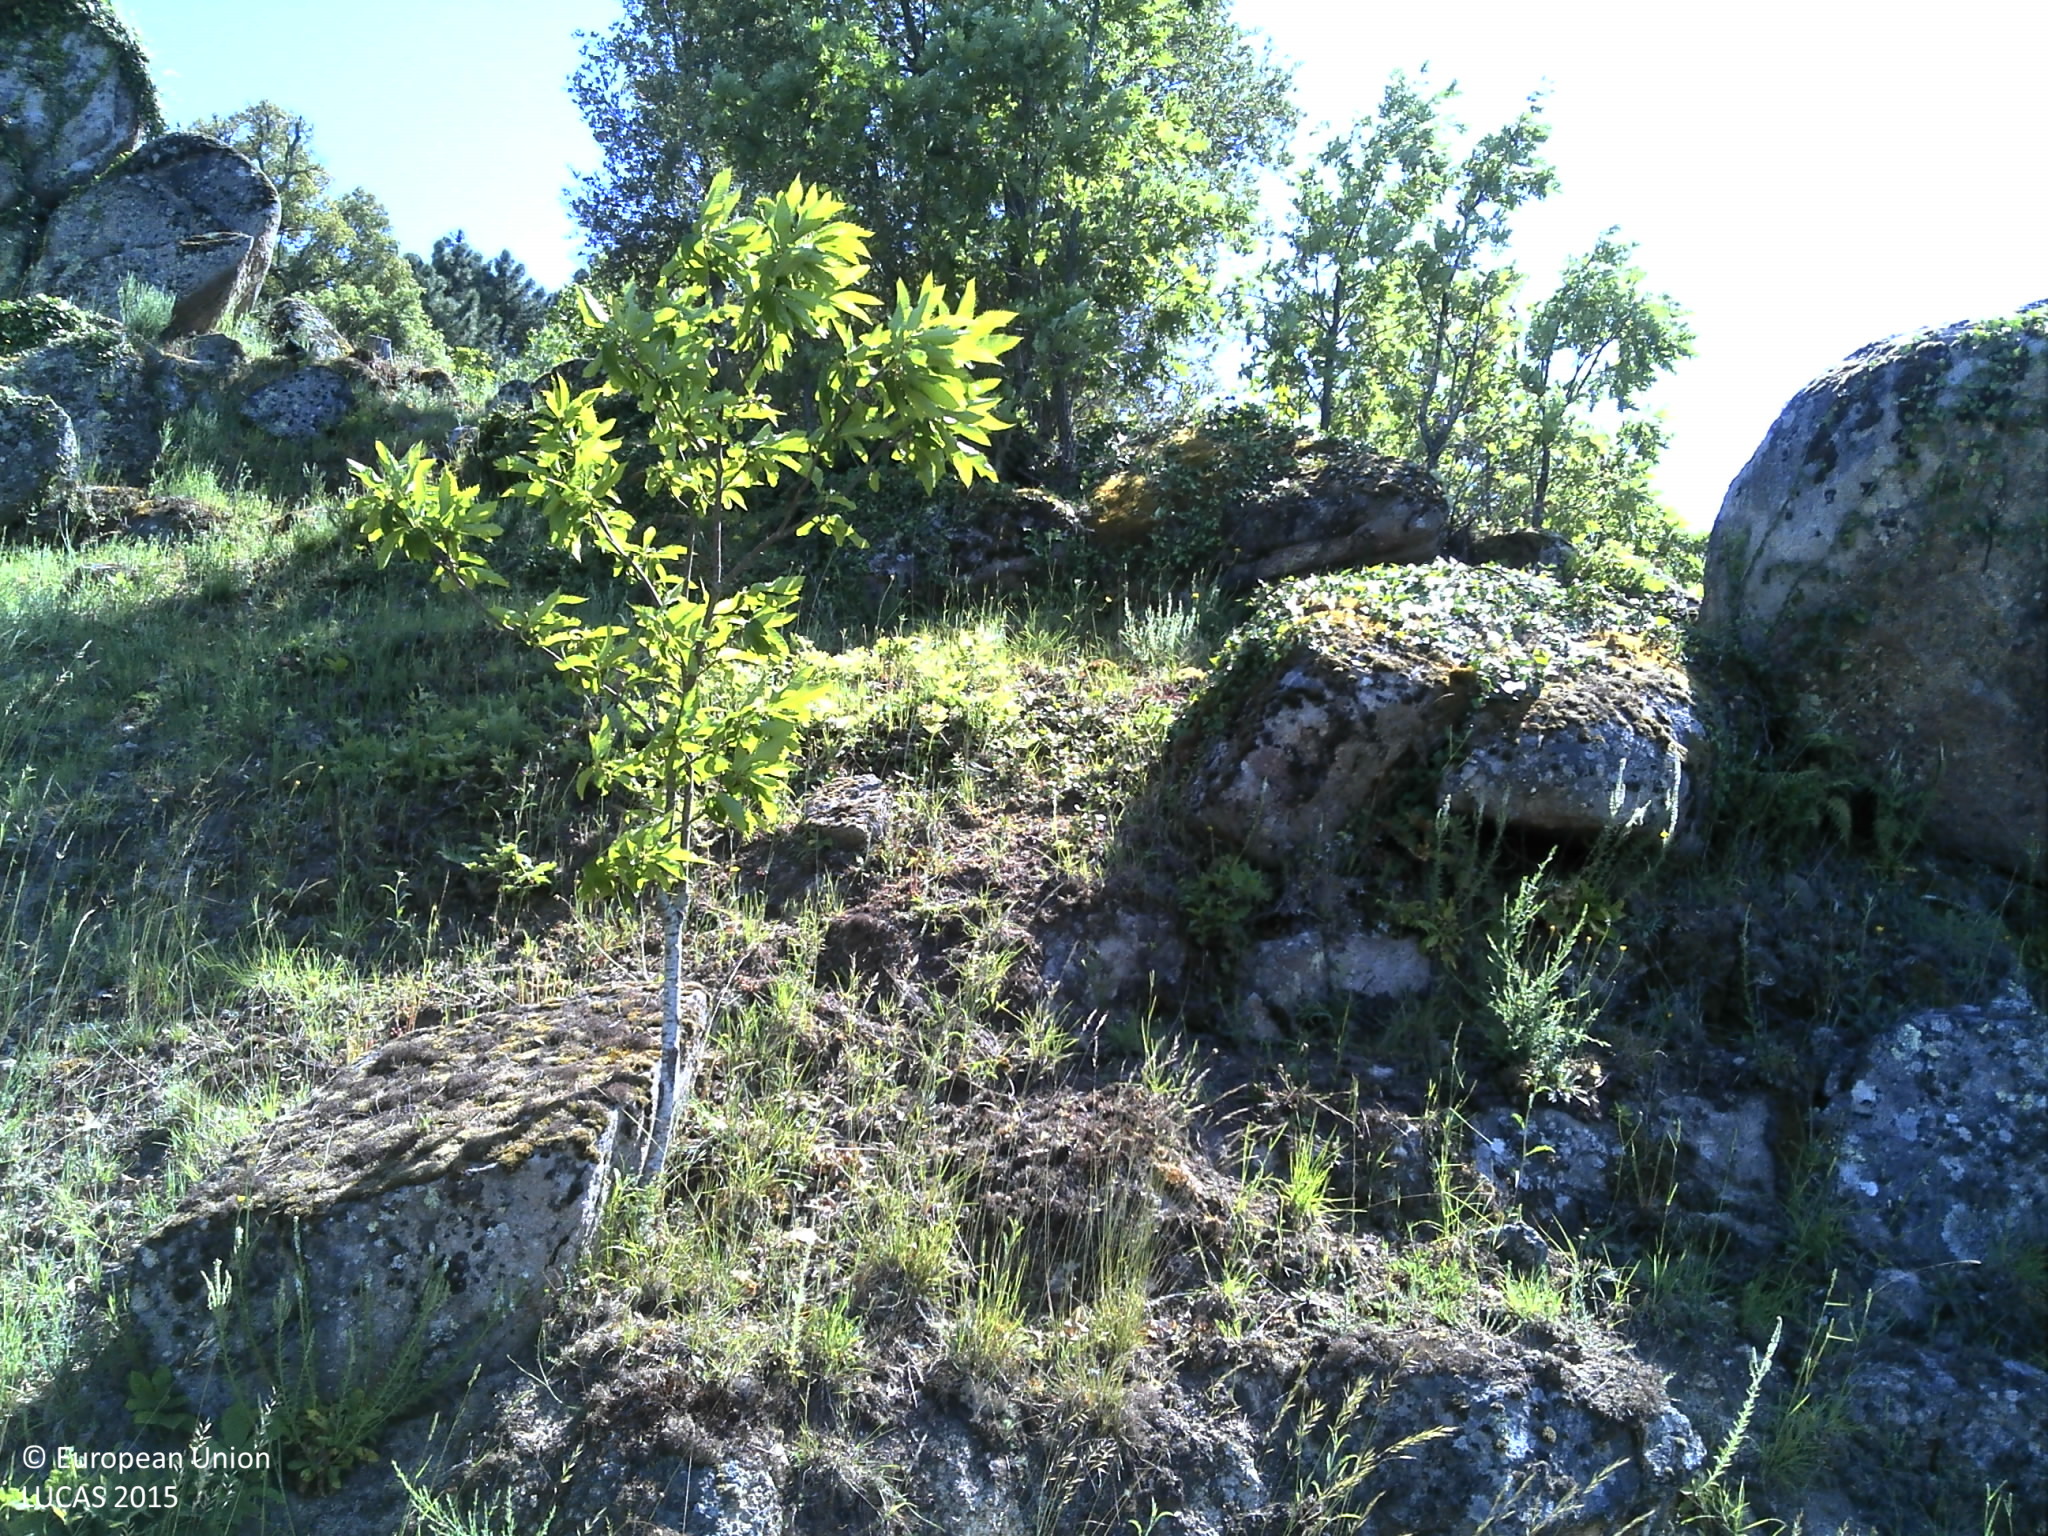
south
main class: Cropland
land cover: Nuts trees
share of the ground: 25 - 50 %
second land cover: Grassland without tree/shrub cover
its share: 50 - 75 %
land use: Agriculture (excluding fallow land and kitchen gardens)
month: May
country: PT
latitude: 41.5853
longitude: -7.5592
